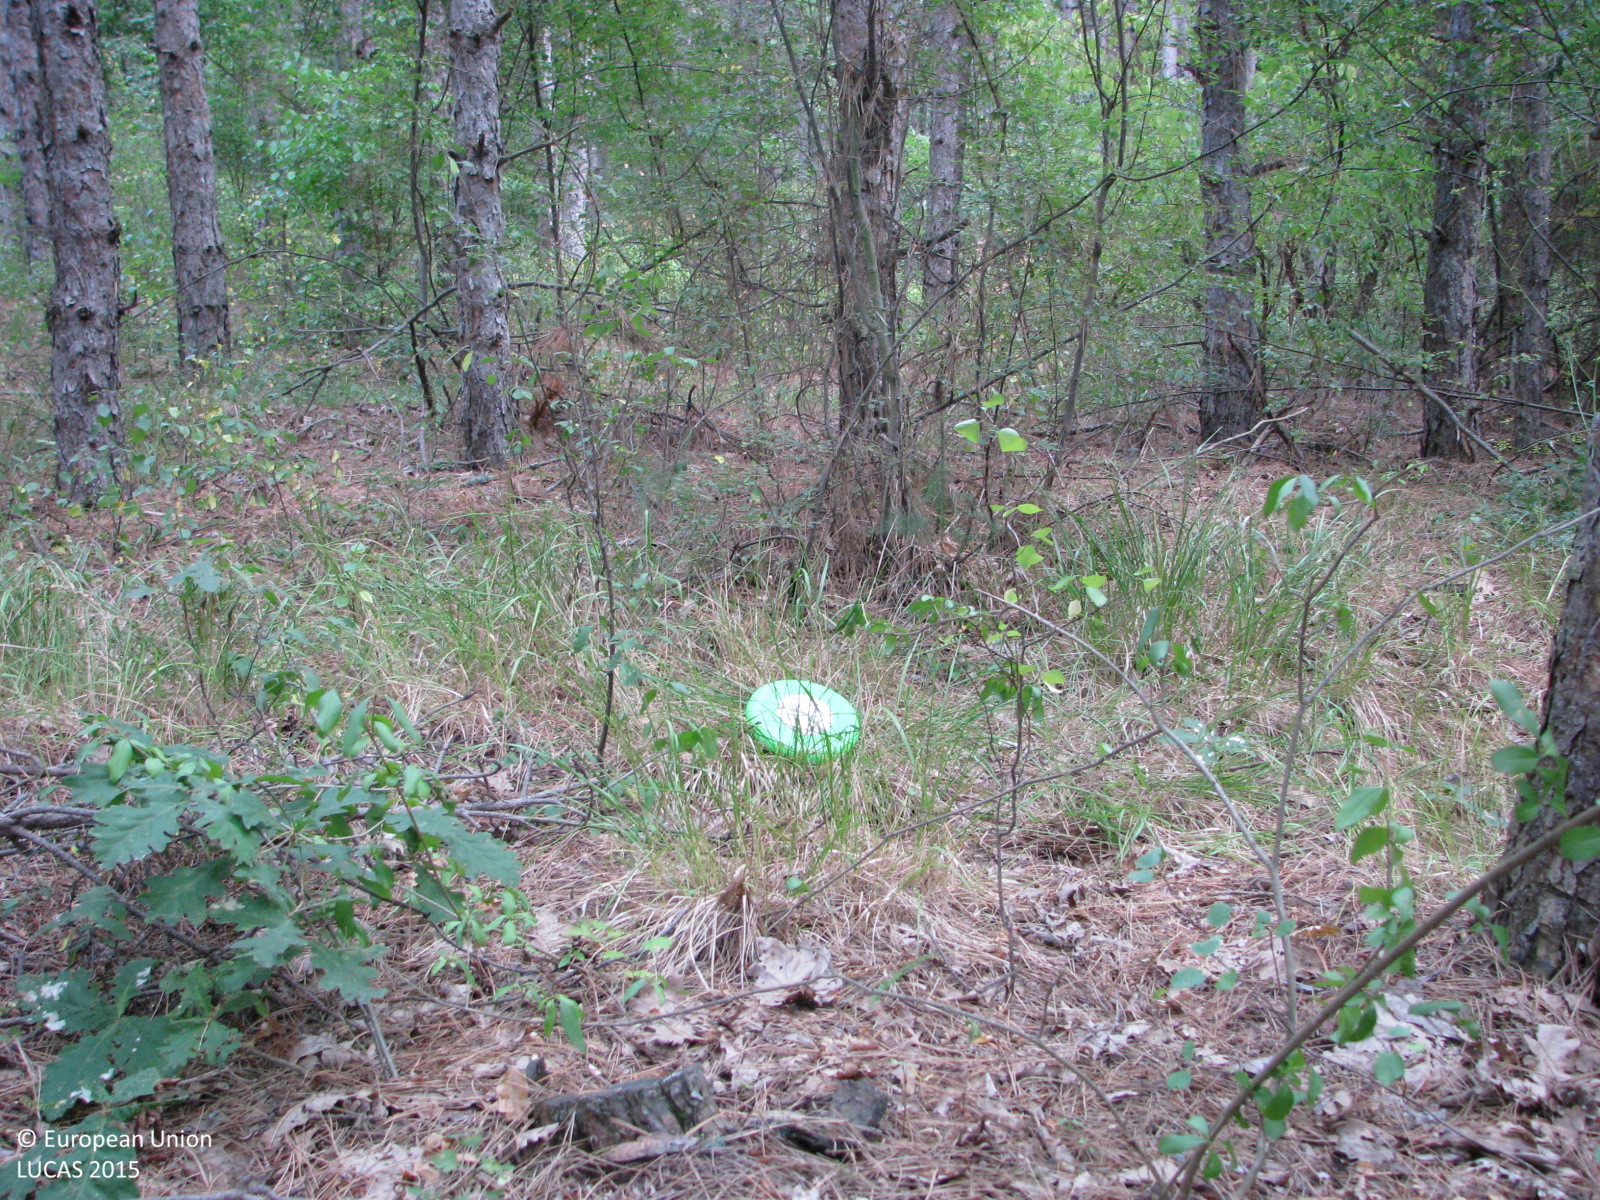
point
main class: Woodland
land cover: Pine dominated mixed woodland
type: hemiboreal forest and nemoral coniferous forest and mixed broadleaved-coniferous forest
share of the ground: > 75 %
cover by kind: coniferous forest trees 50 %, broadleaved forest trees 25 %, shrubs 15 %, herbaceous plants 10 %
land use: Forestry
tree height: > 5 m
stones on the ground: < 10 %
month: August
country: BG
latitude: 42.1051
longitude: 26.7942
